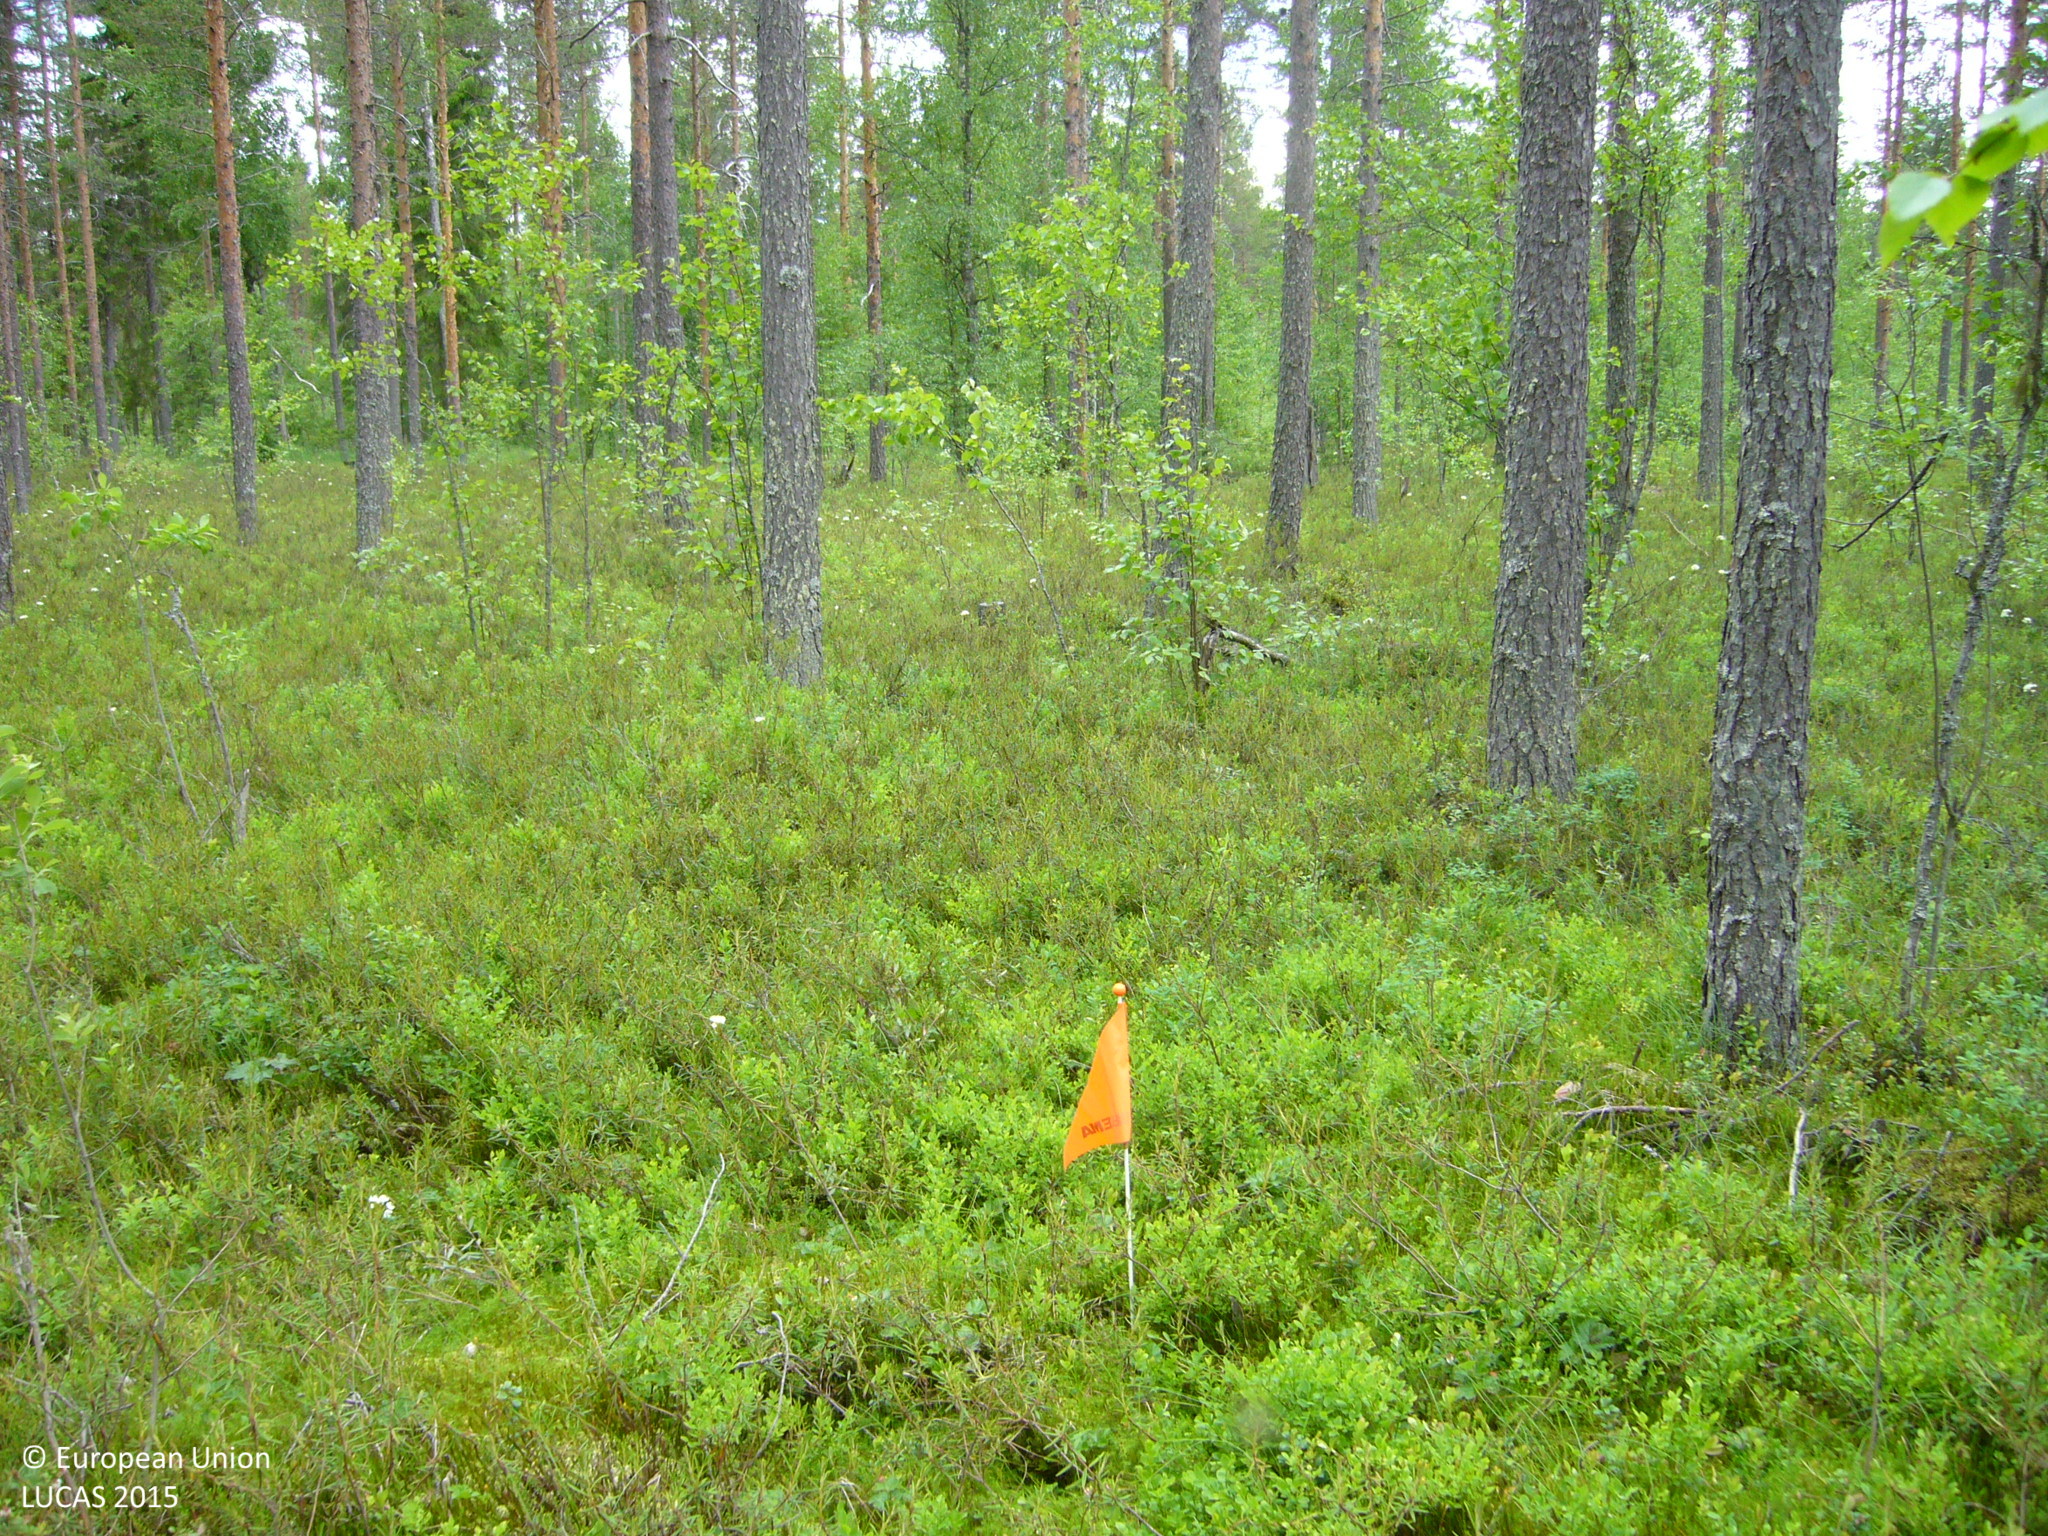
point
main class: Woodland
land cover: Pine dominated mixed woodland
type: boreal forest
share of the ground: > 75 %
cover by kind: coniferous forest trees 60 %, broadleaved forest trees 30 %, shrubs 10 %
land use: Forestry
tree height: > 5 m
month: June
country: FI
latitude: 63.8399
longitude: 26.1536
